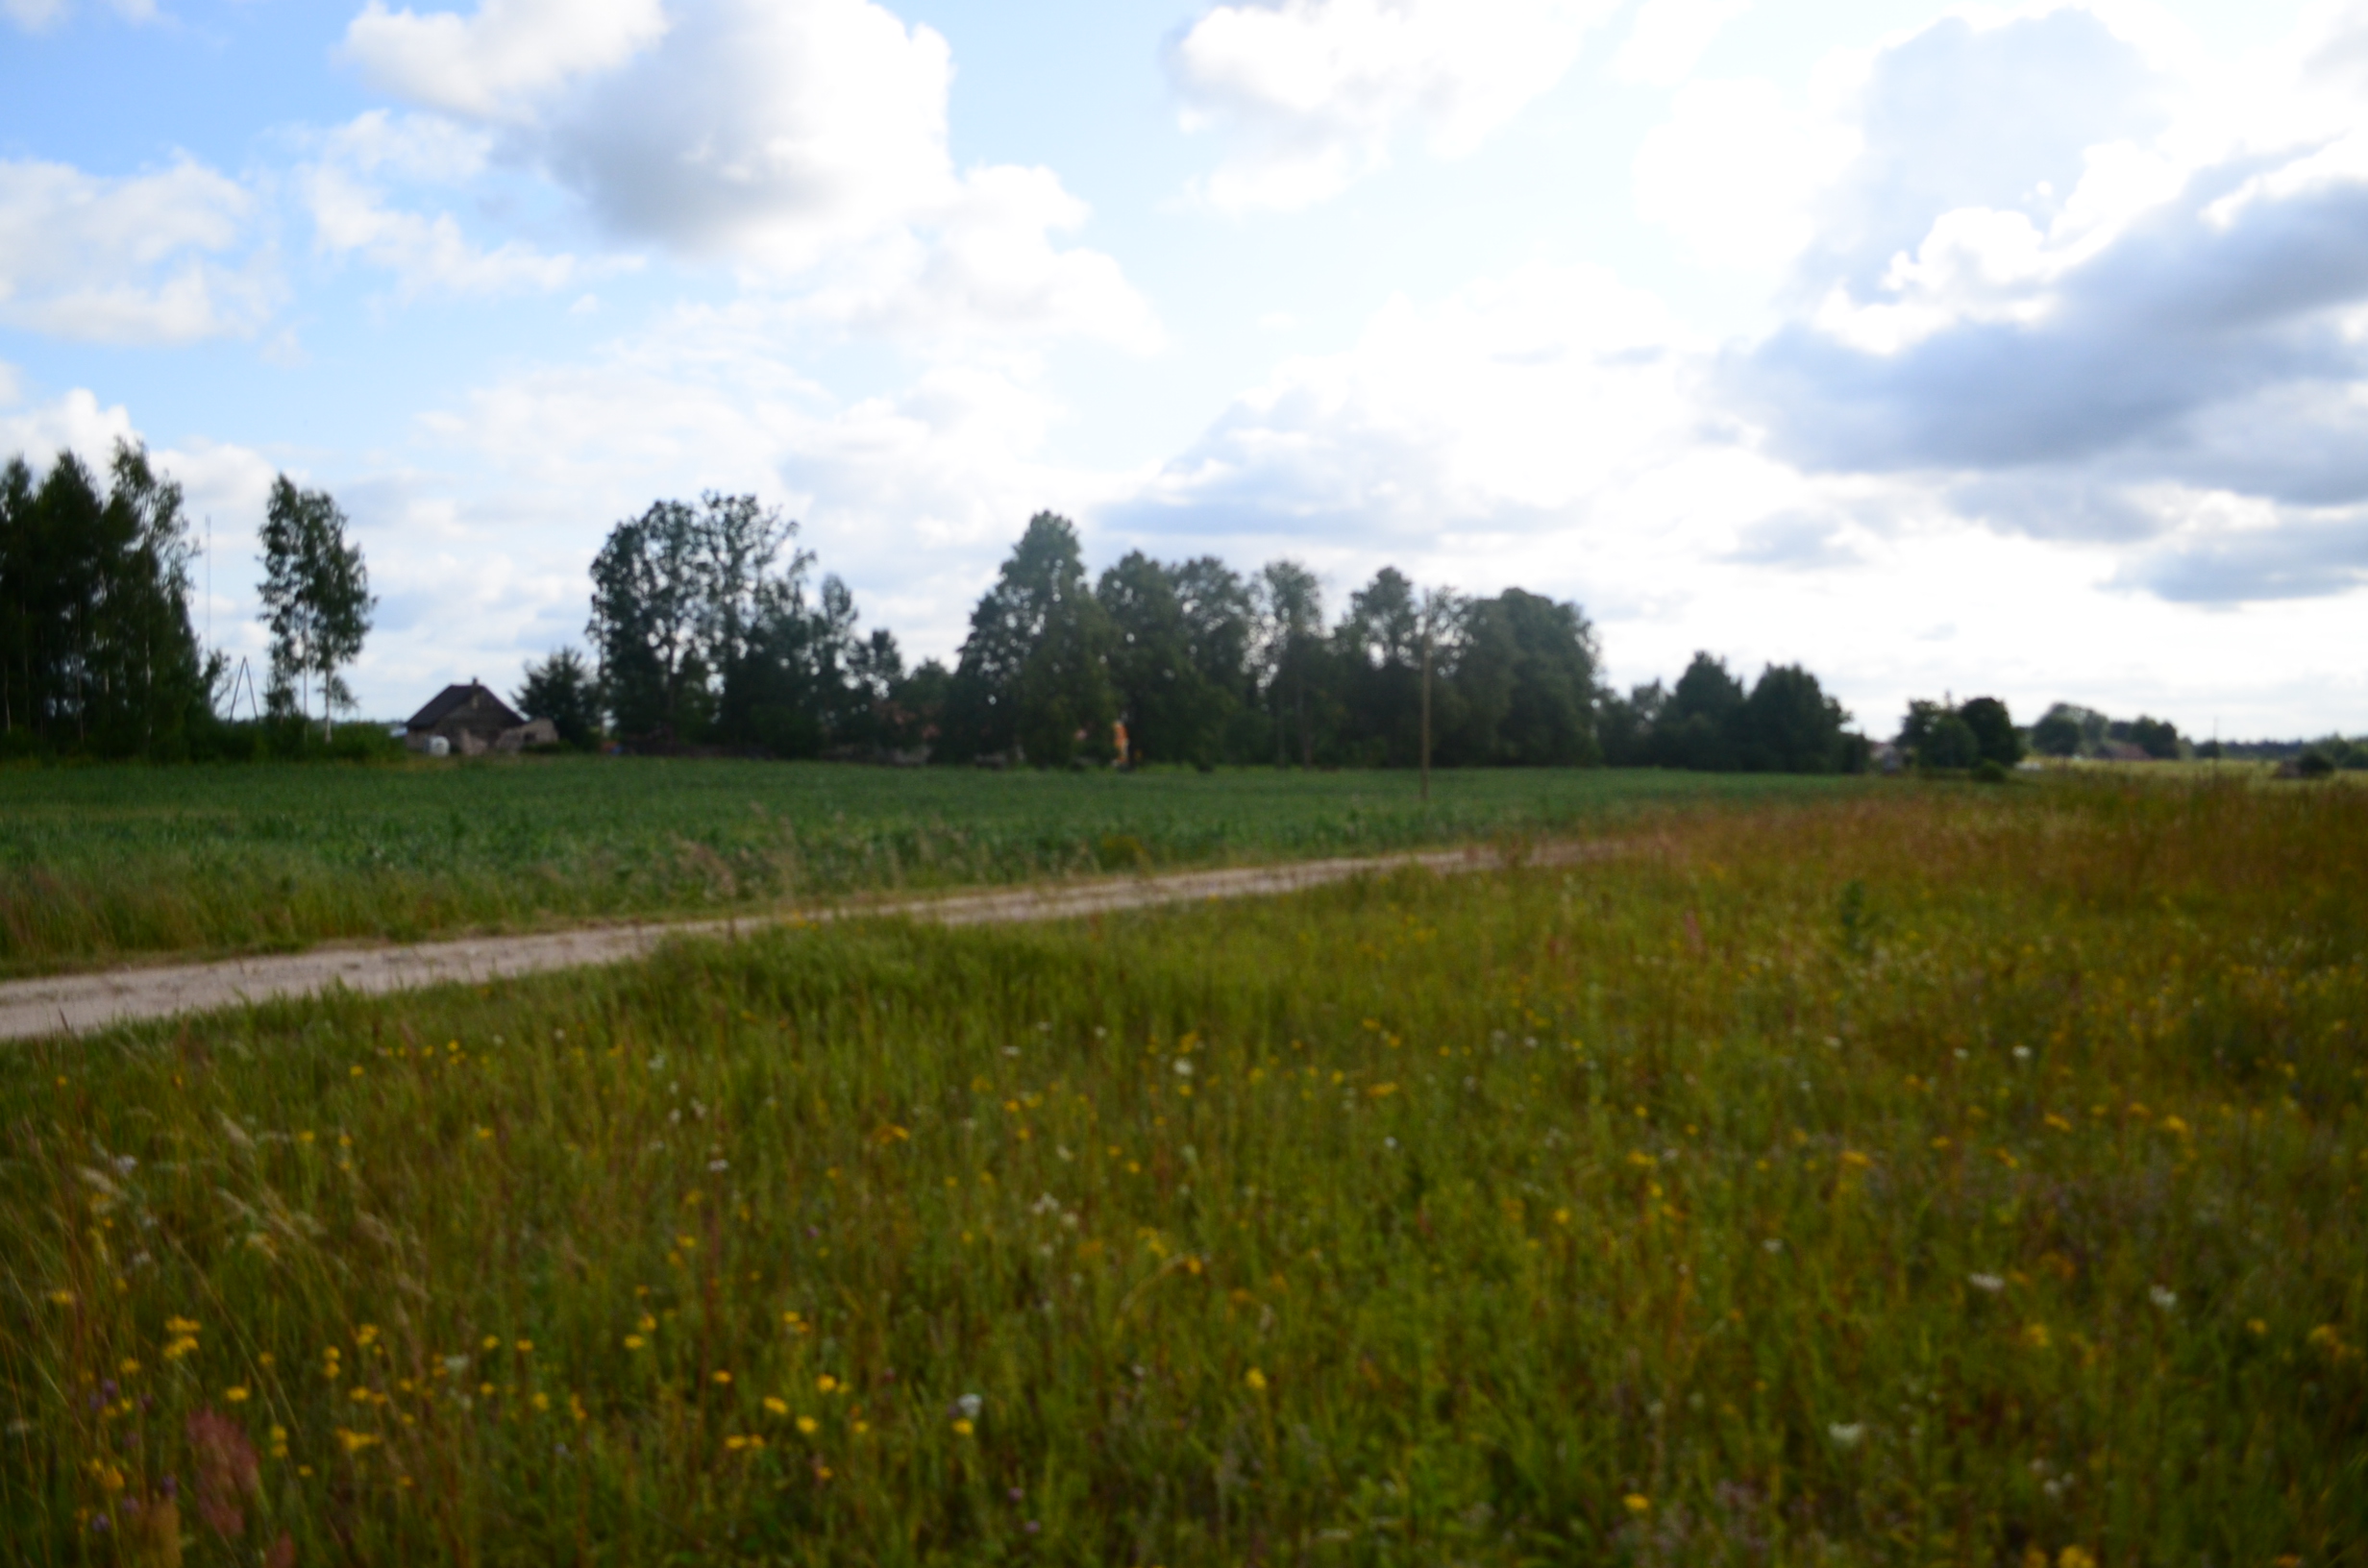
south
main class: Grassland
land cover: Grassland without tree/shrub cover
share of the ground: > 75 %
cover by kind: herbaceous plants 100 %
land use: Agriculture (excluding fallow land and kitchen gardens)
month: July
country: LV
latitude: 57.0703
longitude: 22.4742
